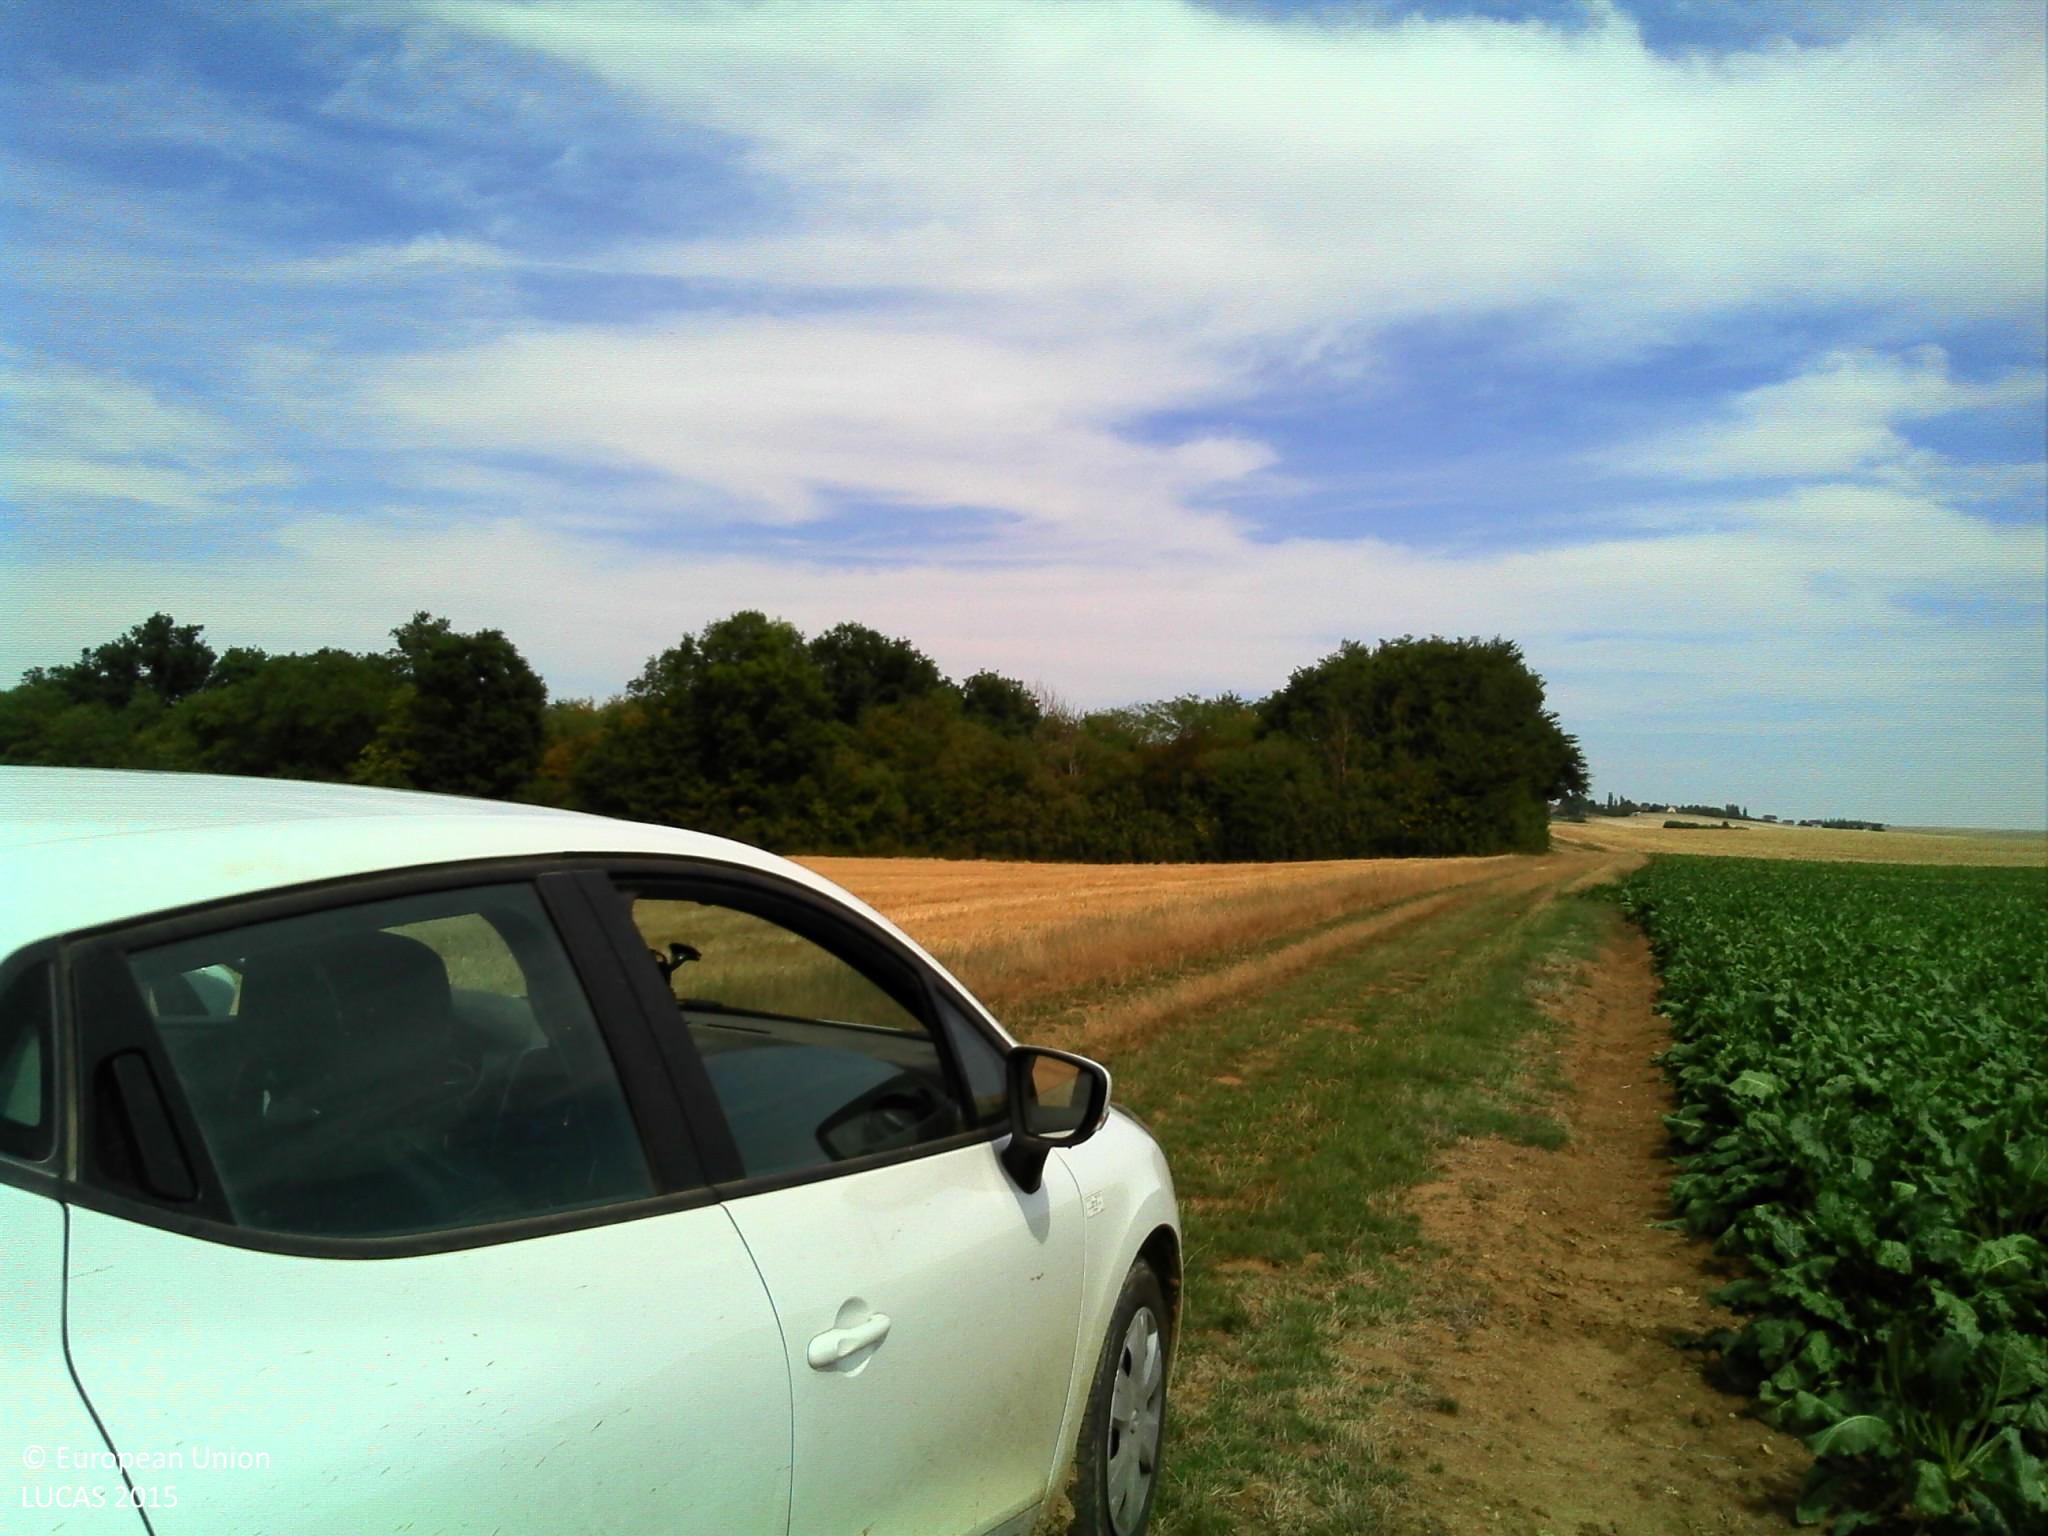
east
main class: Cropland
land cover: Sugar beet
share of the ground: > 75 %
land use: Agriculture (excluding fallow land and kitchen gardens)
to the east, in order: Sugar beet; Barley
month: August
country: FR
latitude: 48.2383
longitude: 2.4901
